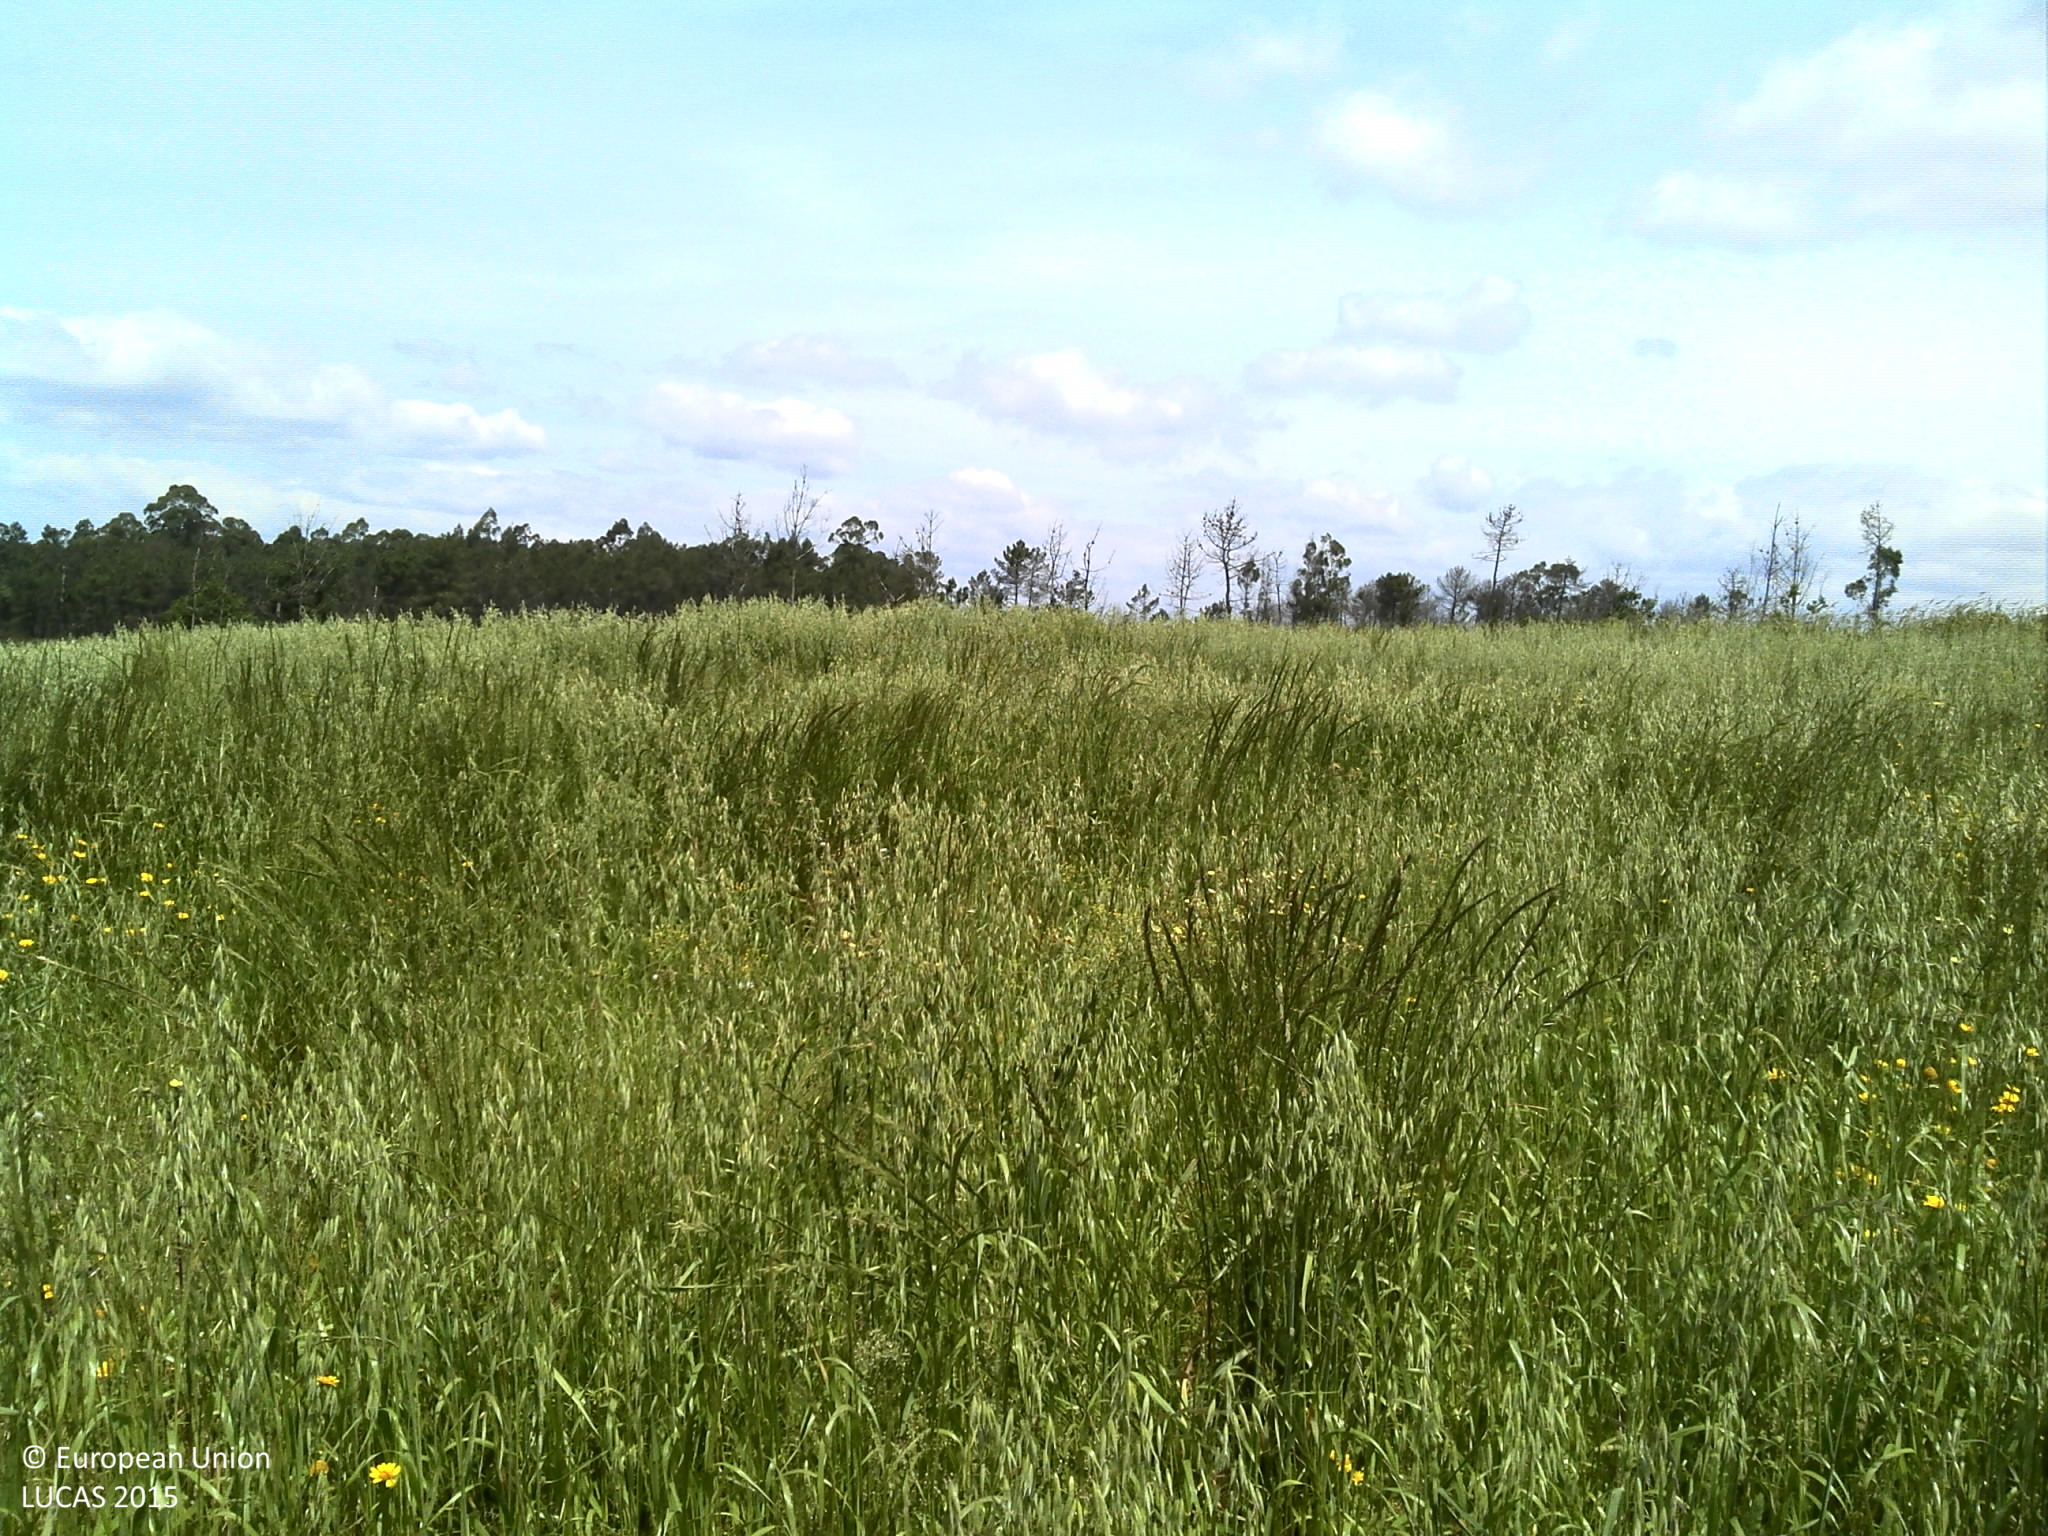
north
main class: Cropland
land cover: Mixed cereals for fodder
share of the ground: > 75 %
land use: Agriculture (excluding fallow land and kitchen gardens)
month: May
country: PT
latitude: 41.4483
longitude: -8.7019
